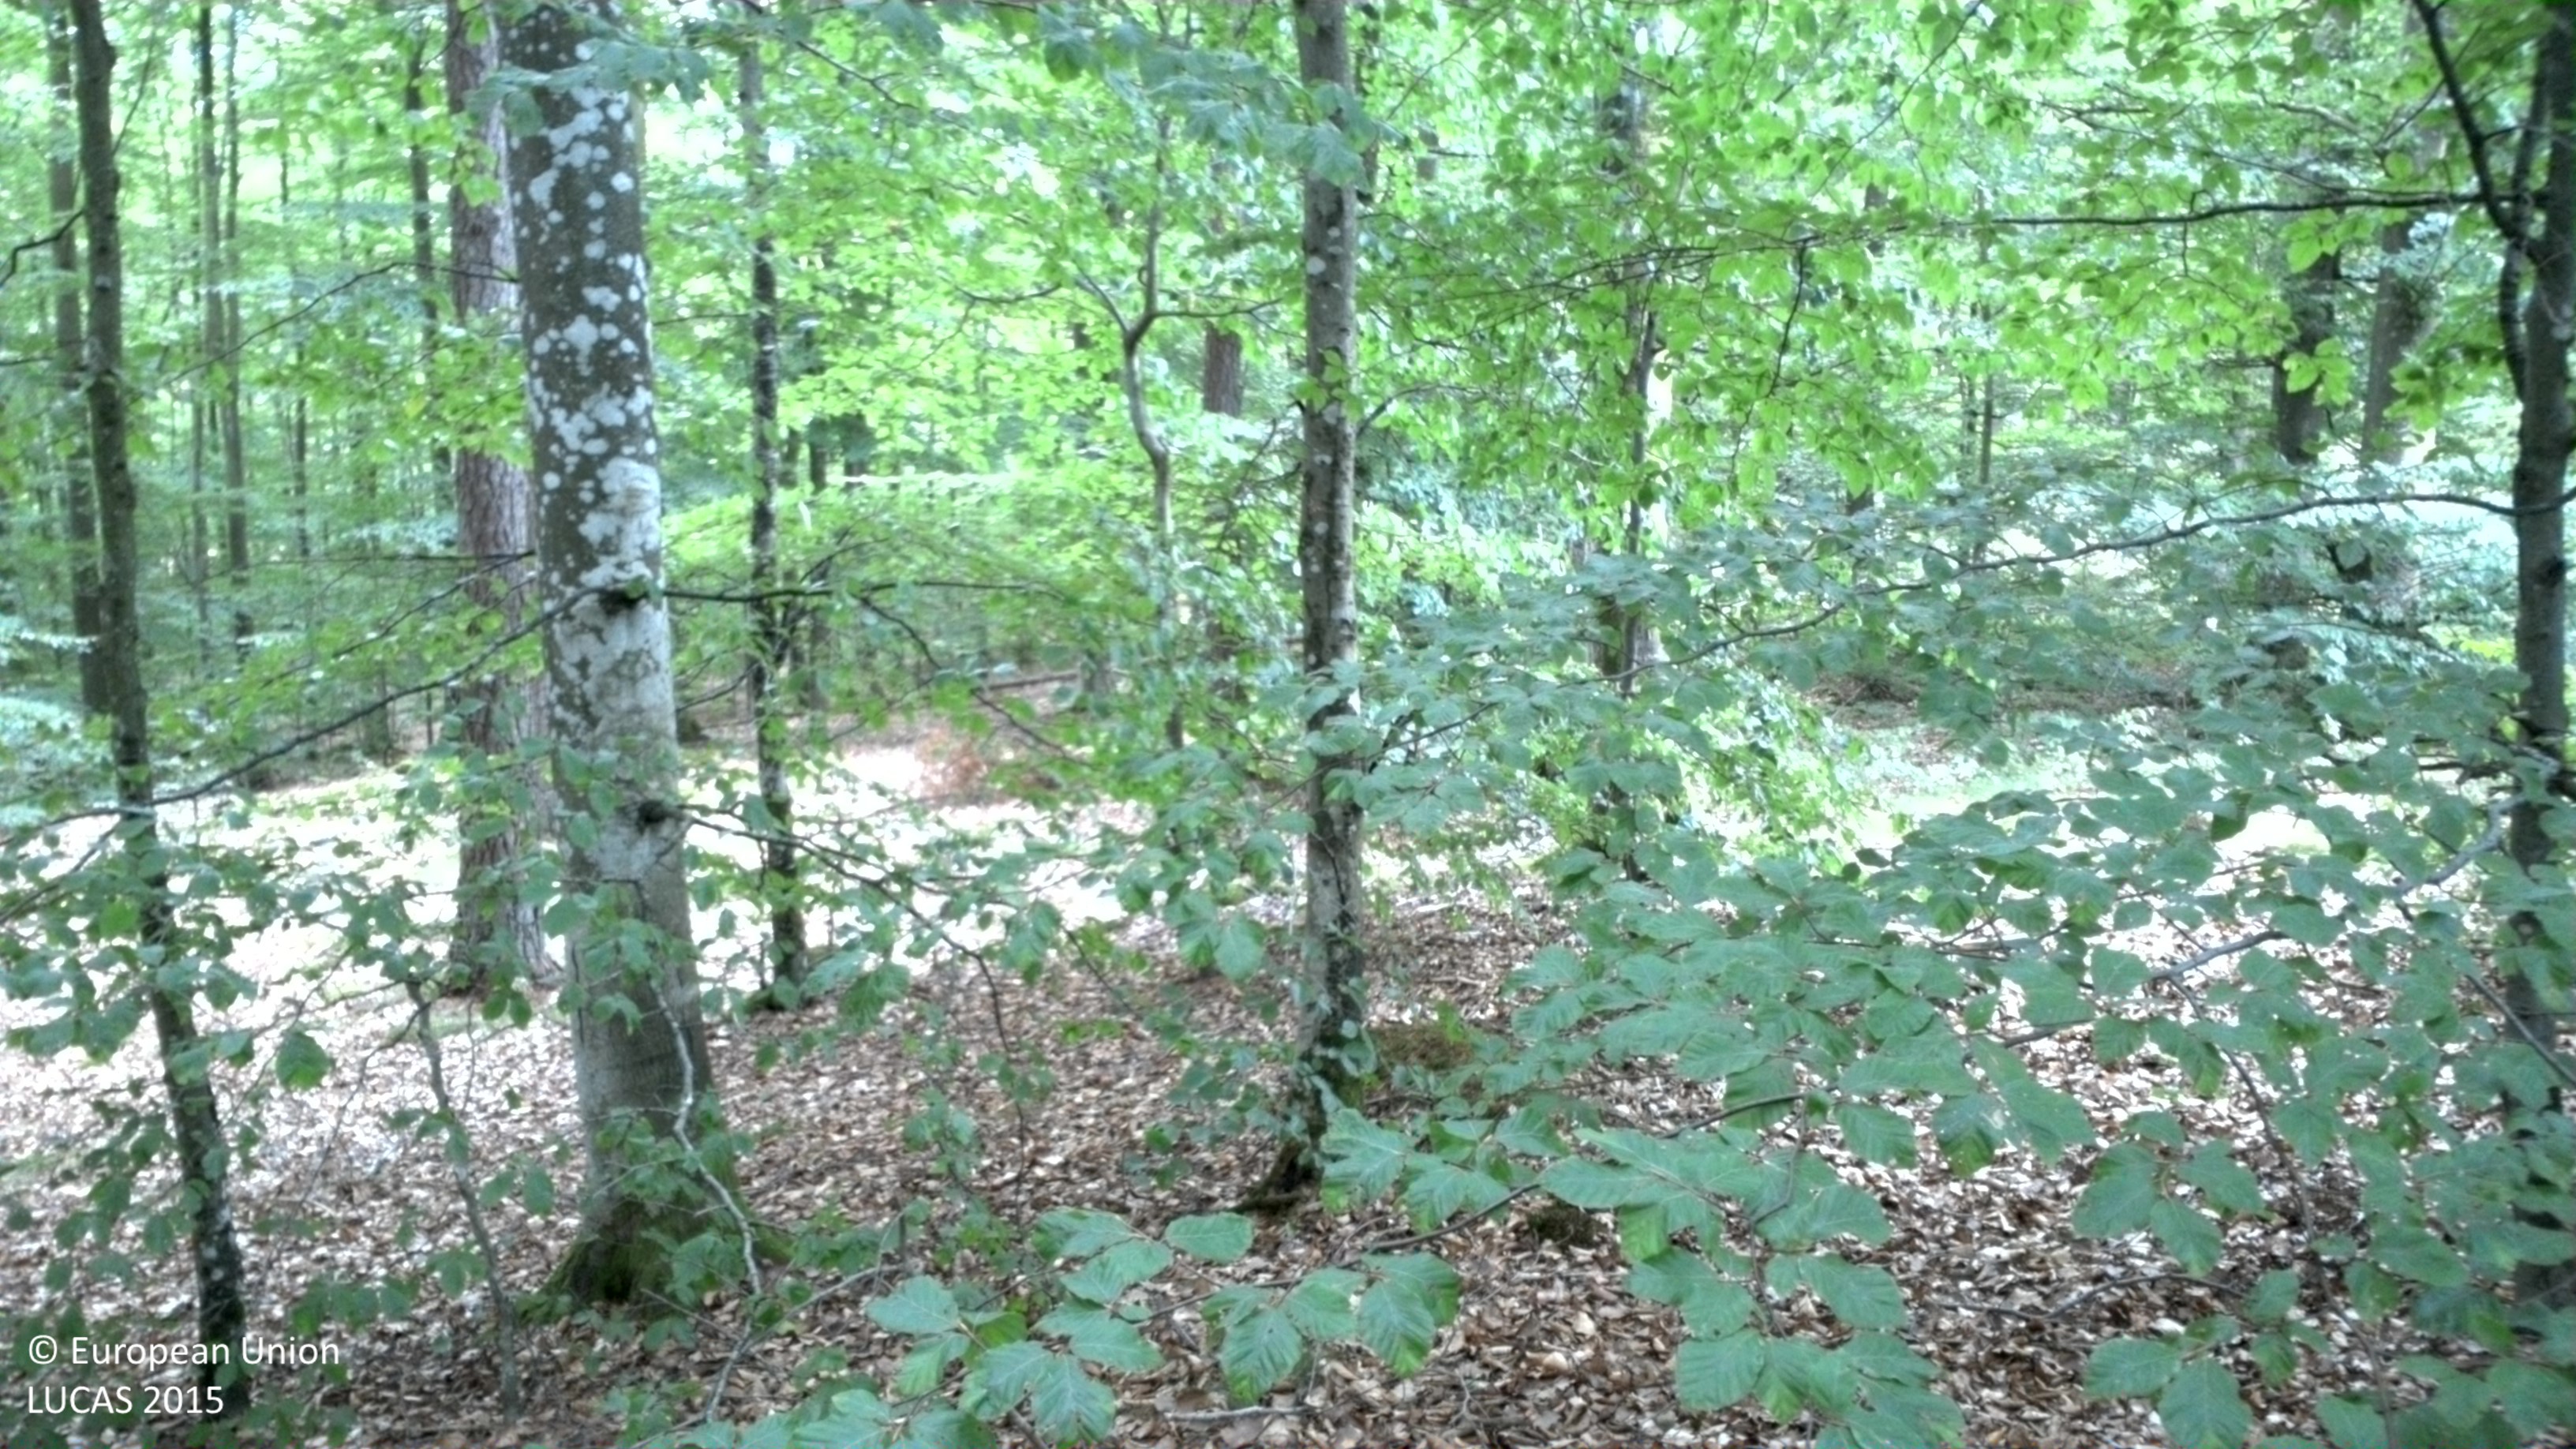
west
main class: Woodland
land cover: Broadleaved woodland
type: beech forest
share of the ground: > 75 %
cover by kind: broadleaved forest trees 85 %
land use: Forestry
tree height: > 5 m
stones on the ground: < 10 %
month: September
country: SE
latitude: 56.1498
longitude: 14.3602
